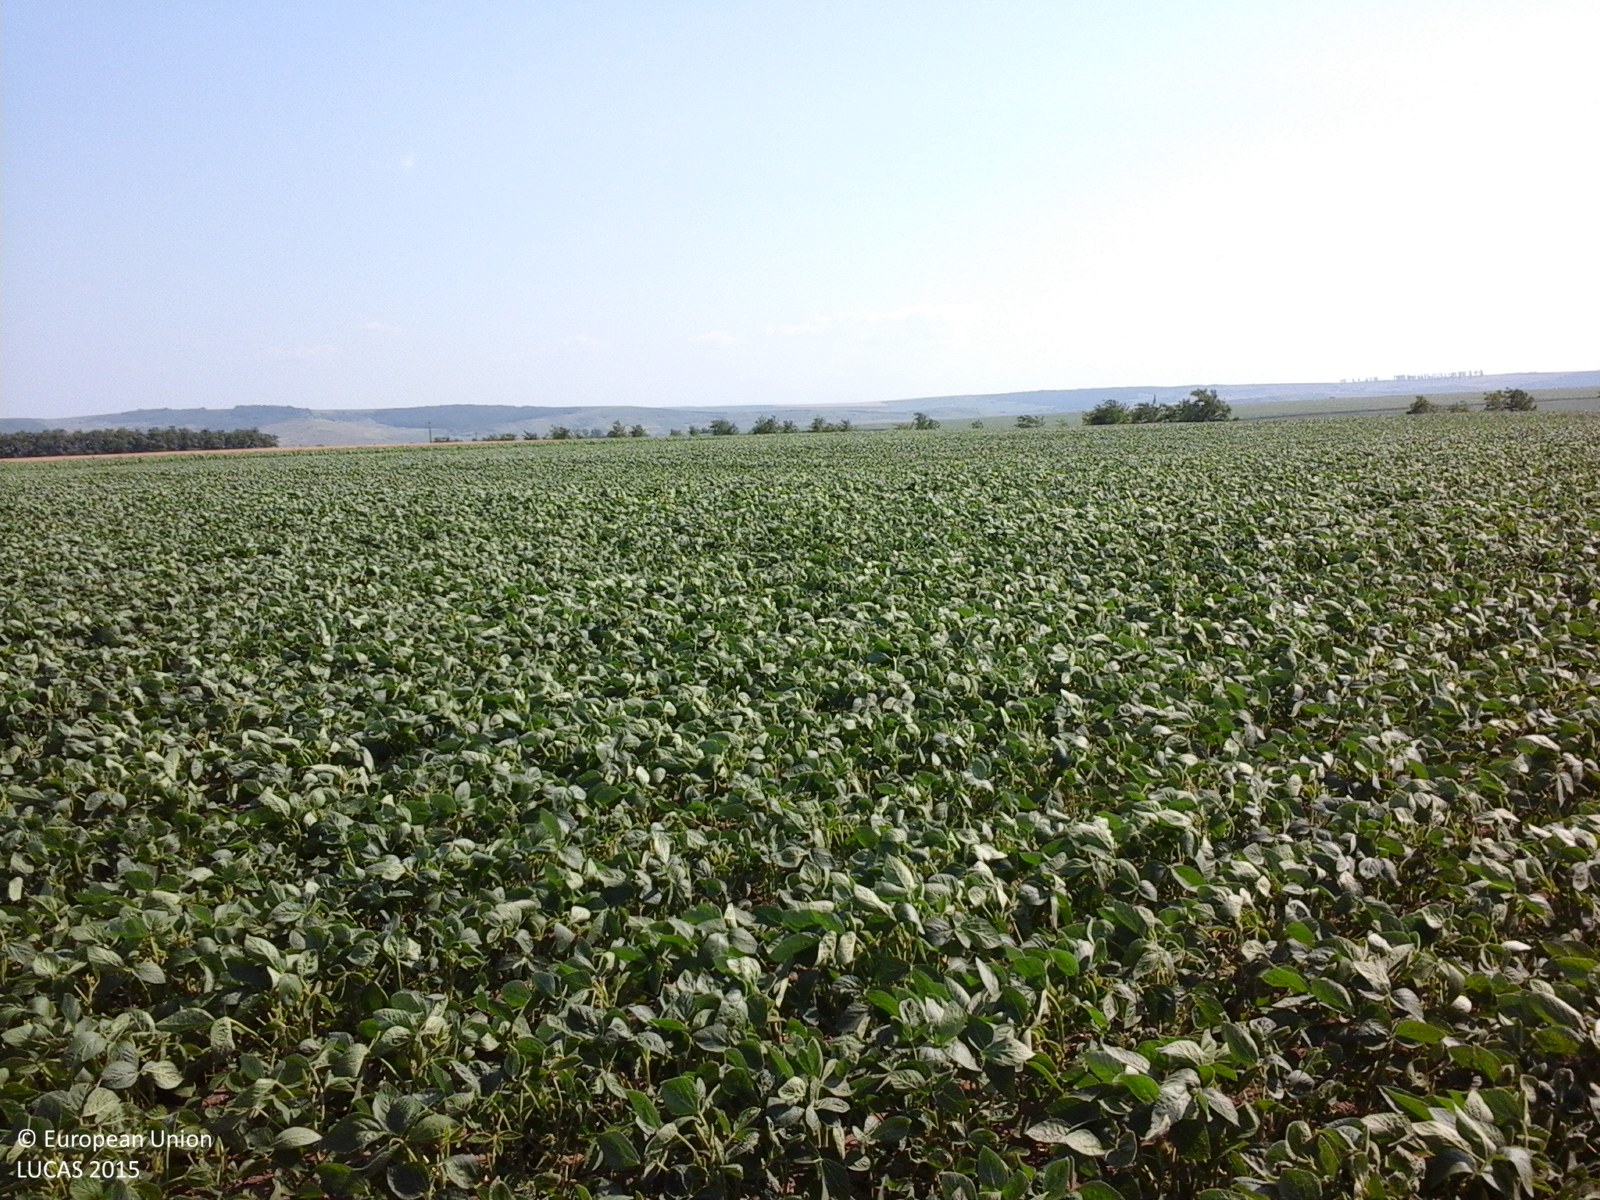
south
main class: Cropland
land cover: Soya
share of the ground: > 75 %
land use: Agriculture (excluding fallow land and kitchen gardens)
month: June
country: RO
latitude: 47.3477
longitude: 27.4701
